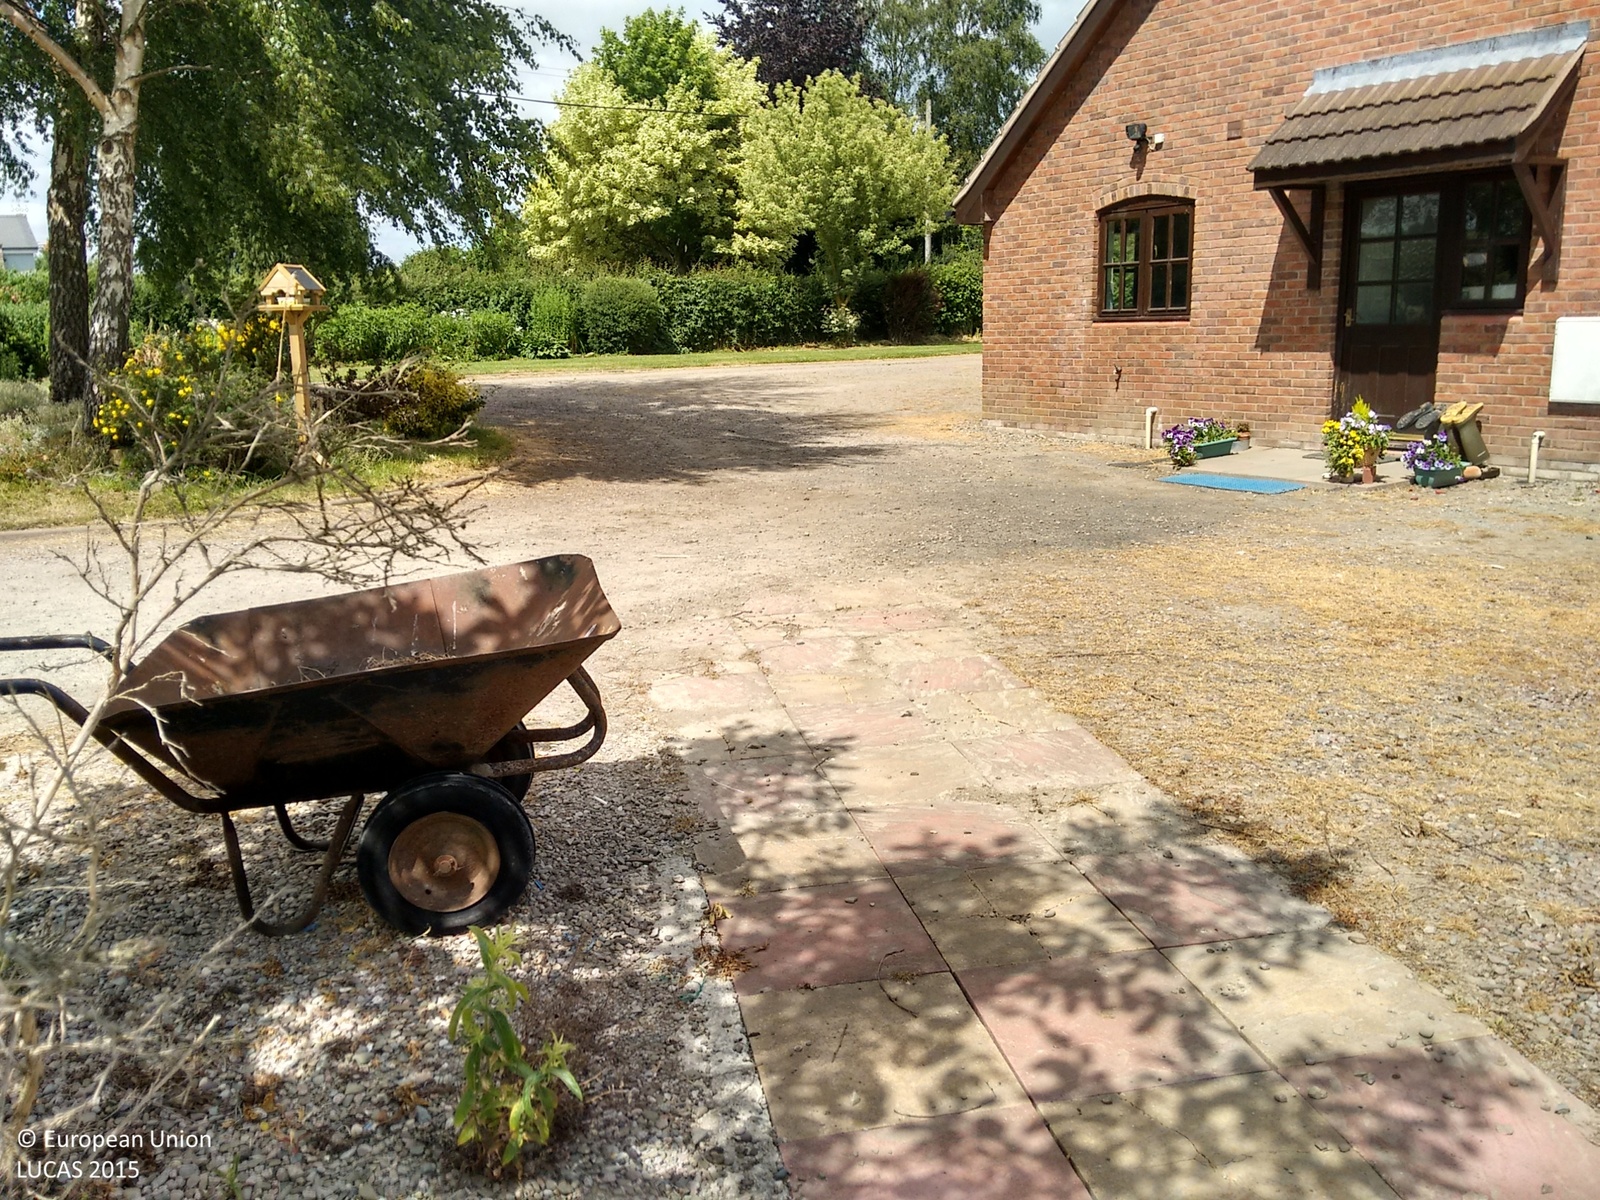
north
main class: Grassland
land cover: Grassland without tree/shrub cover
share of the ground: > 75 %
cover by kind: herbaceous plants 100 %
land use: Agriculture (excluding fallow land and kitchen gardens)
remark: Harvested field
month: June
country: GB
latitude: 52.2695
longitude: -2.7464
